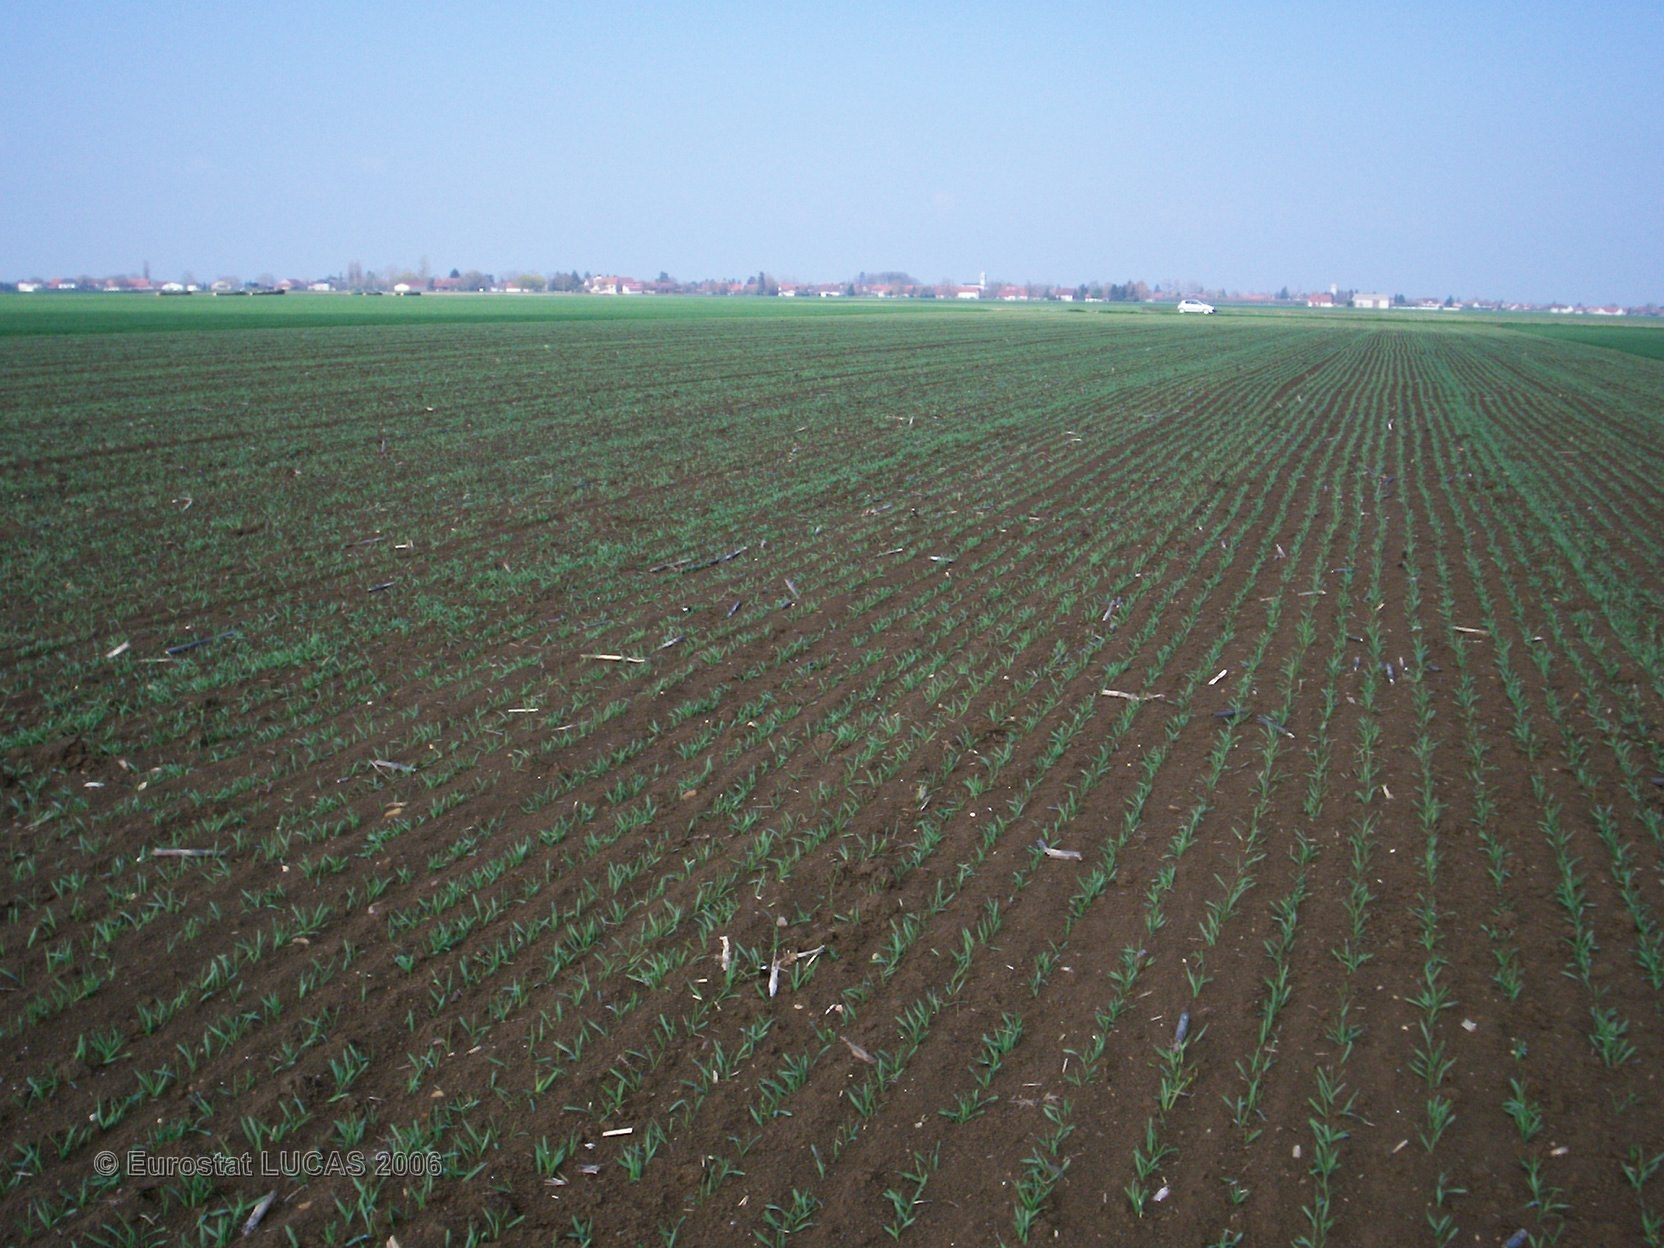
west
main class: Cropland
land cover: Rye
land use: Agriculture (excluding fallow land and kitchen gardens)
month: April
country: FR
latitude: 47.0260
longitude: 5.3569
